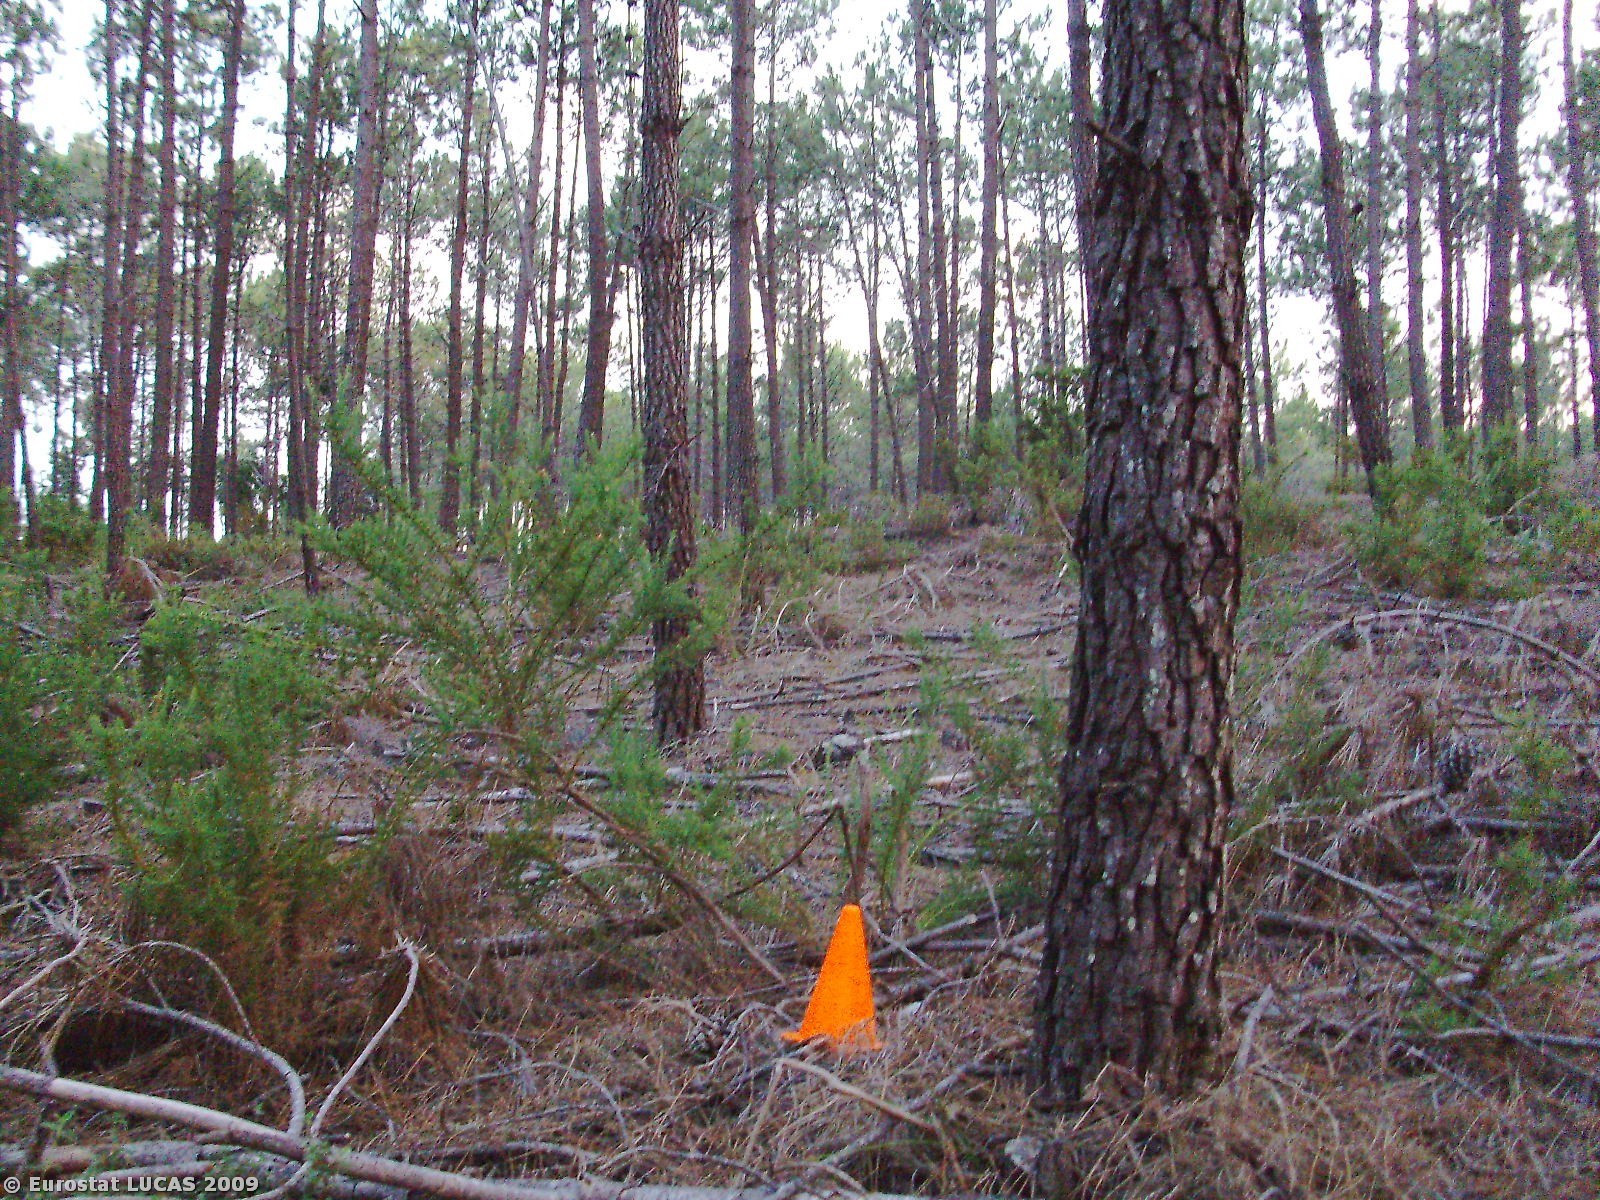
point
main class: Woodland
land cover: Coniferous woodland
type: coniferous forest of the mediterranean region
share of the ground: > 75 %
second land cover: Shrubland with sparse tree cover
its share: 10 - 25 %
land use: Forestry
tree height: > 5 m
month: July
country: PT
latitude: 39.6281
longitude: -9.0217
